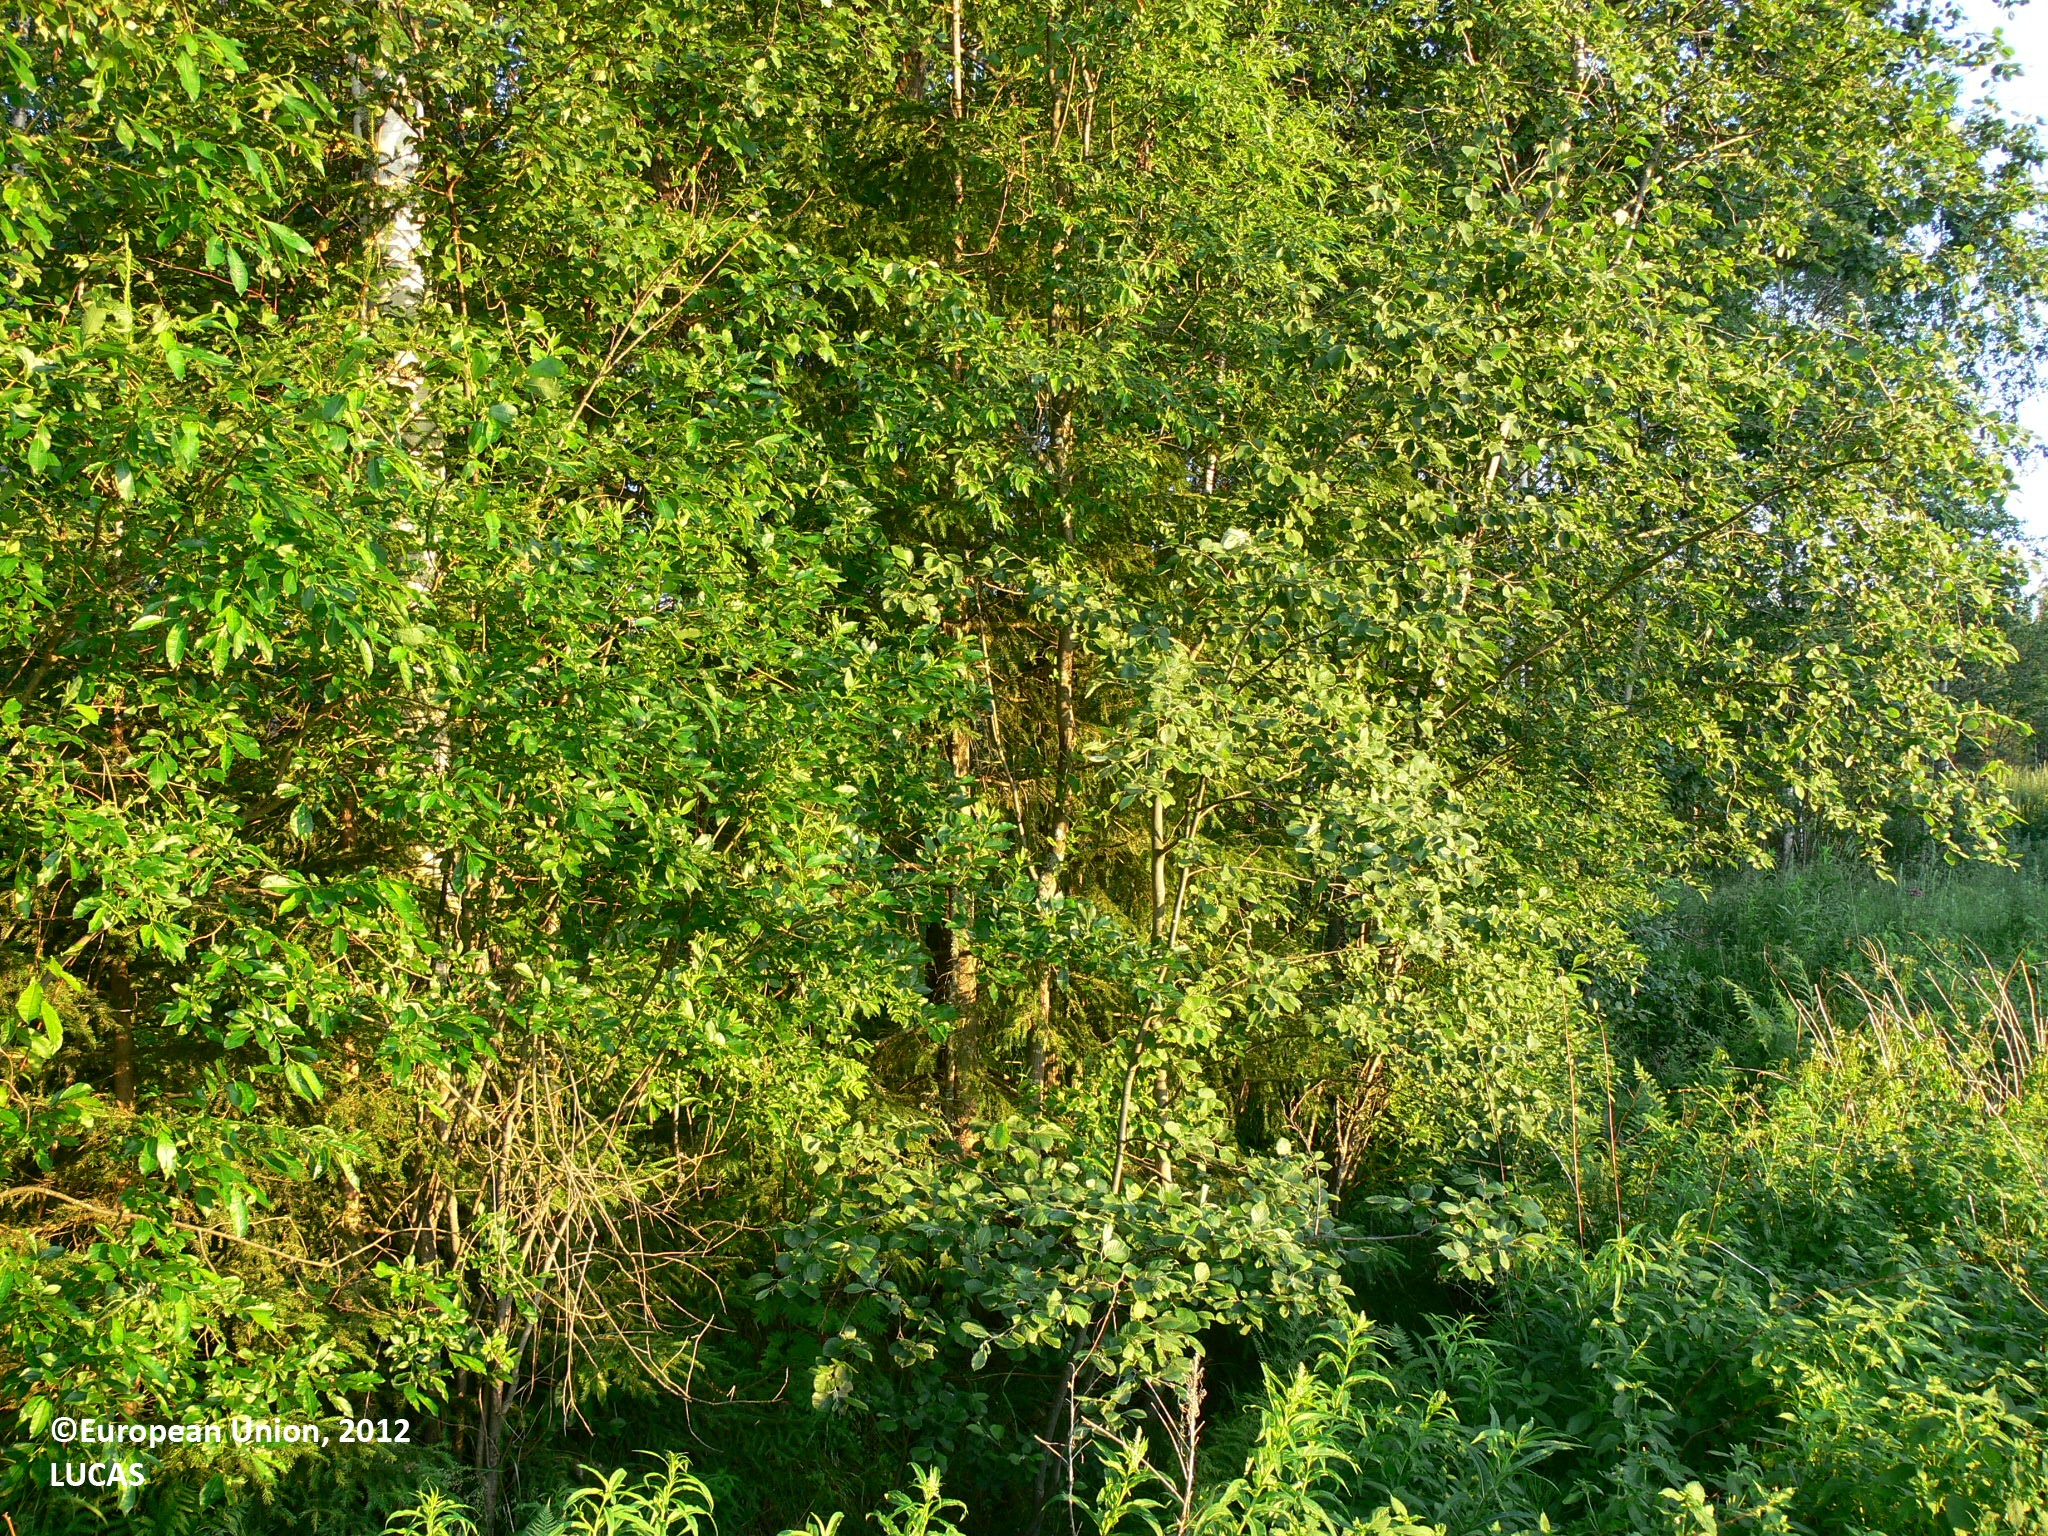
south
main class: Cropland
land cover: Barley
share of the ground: > 75 %
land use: Agriculture (excluding fallow land and kitchen gardens)
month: July
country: FI
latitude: 62.2902
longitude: 29.6207
